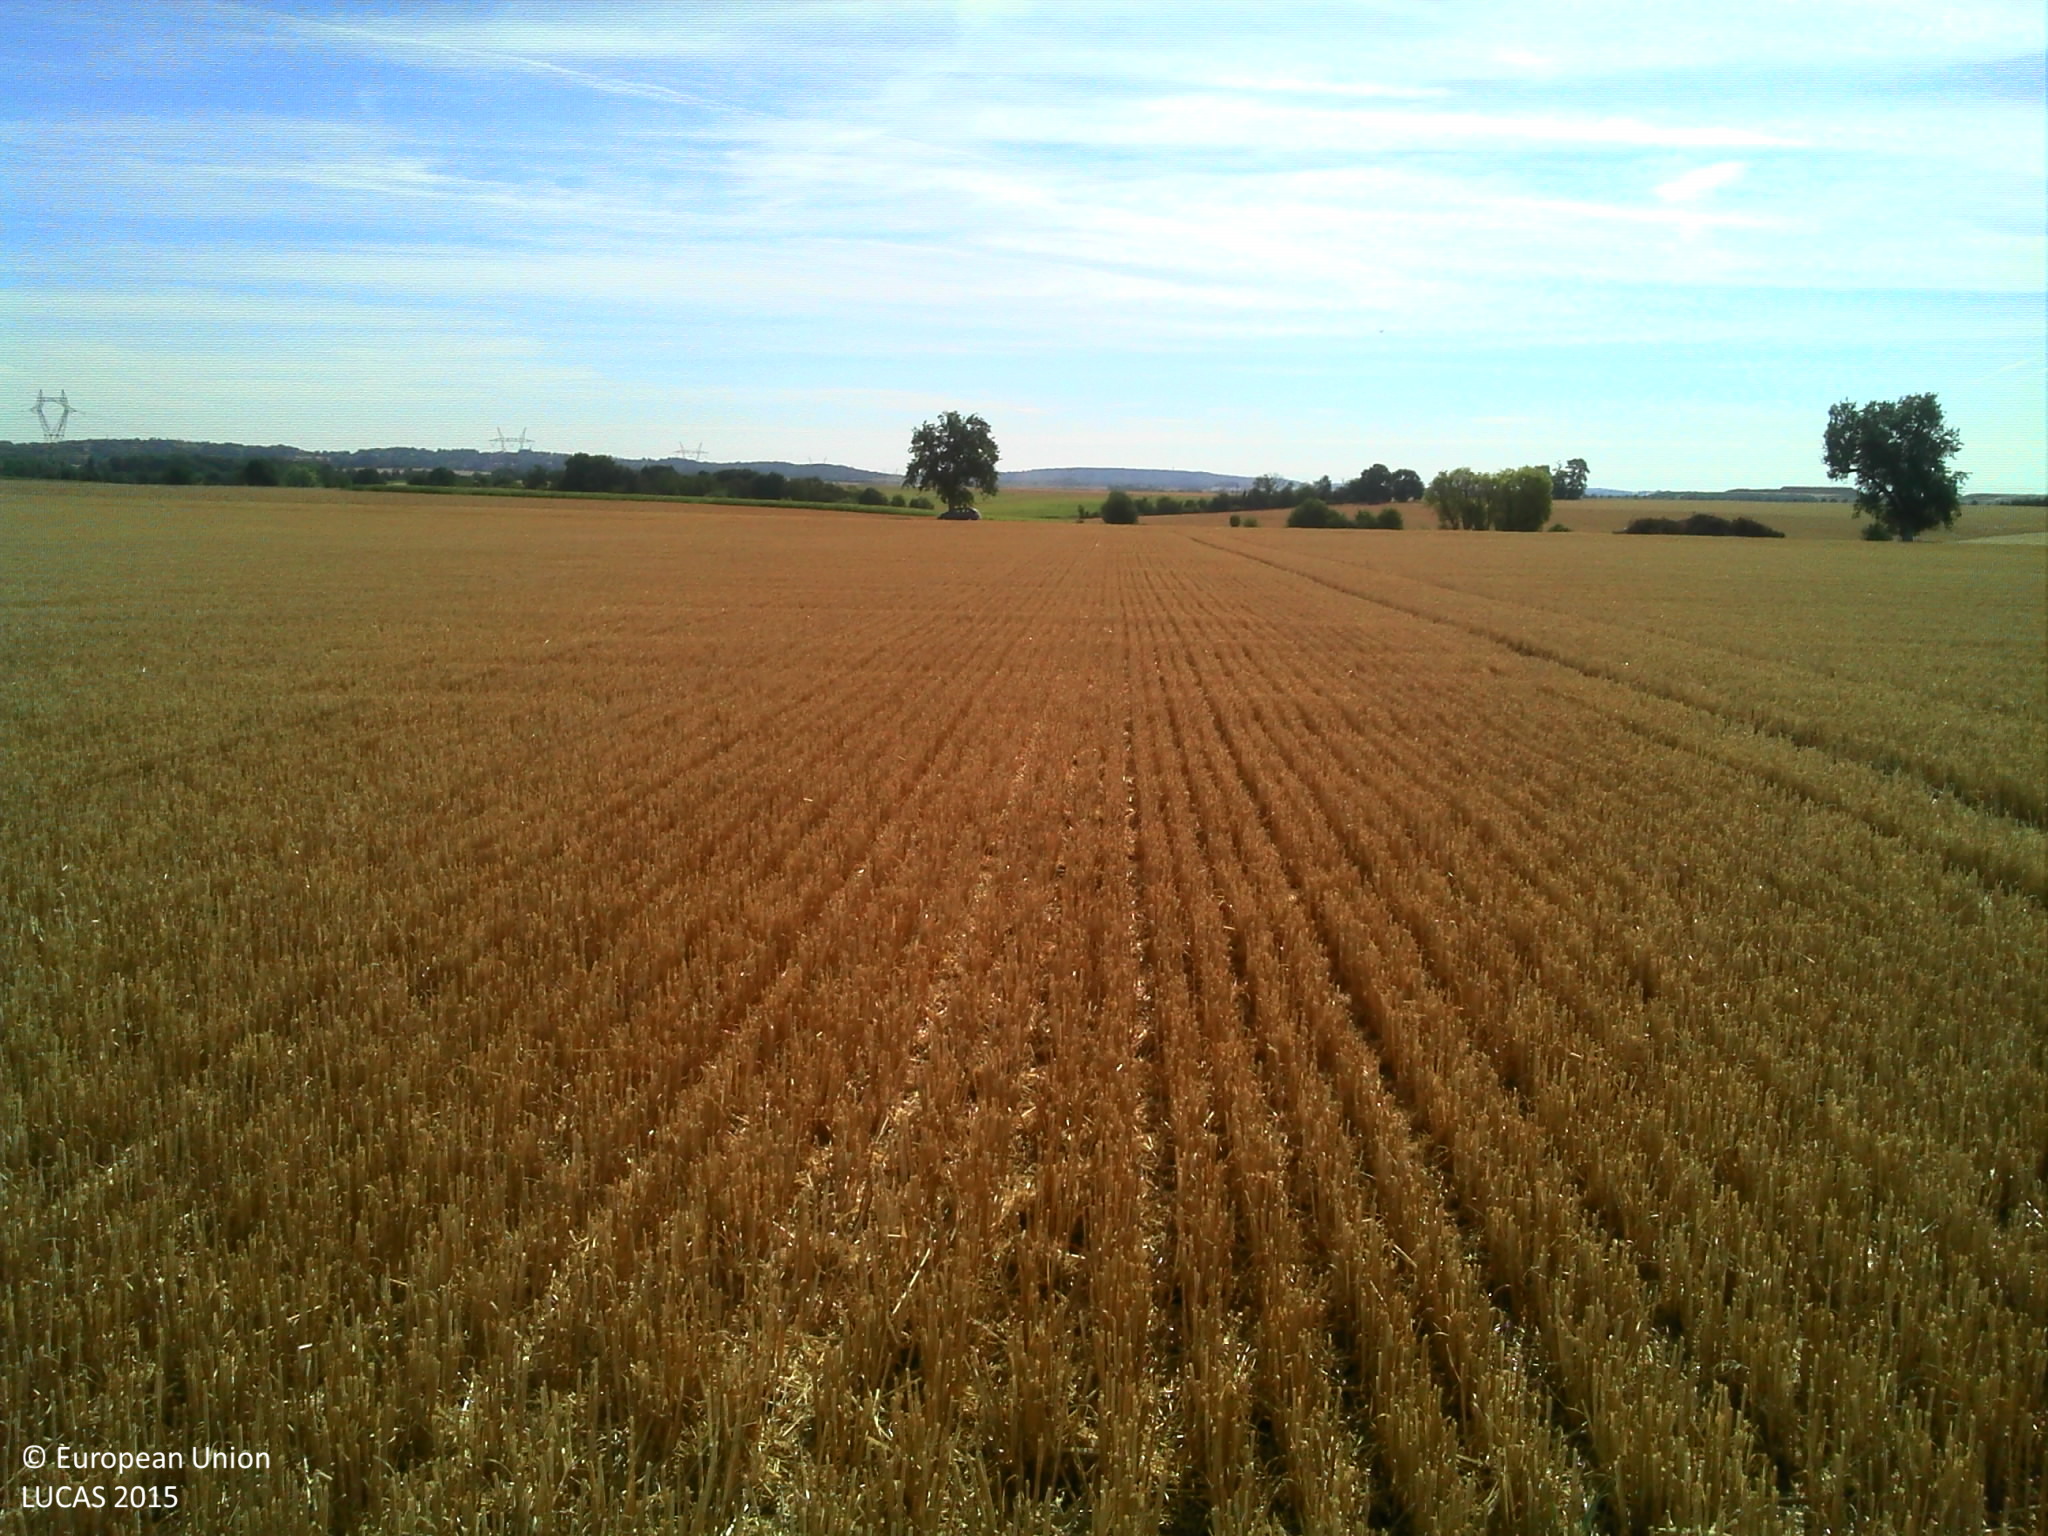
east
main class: Cropland
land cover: Common wheat
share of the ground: > 75 %
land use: Agriculture (excluding fallow land and kitchen gardens)
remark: Harvested field
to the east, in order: Common wheat; Grass margins; Paved roads, cycling and walking lanes; Grass margins; Single bushes/trees; Common wheat
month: August
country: FR
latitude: 49.0398
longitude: 2.5882
